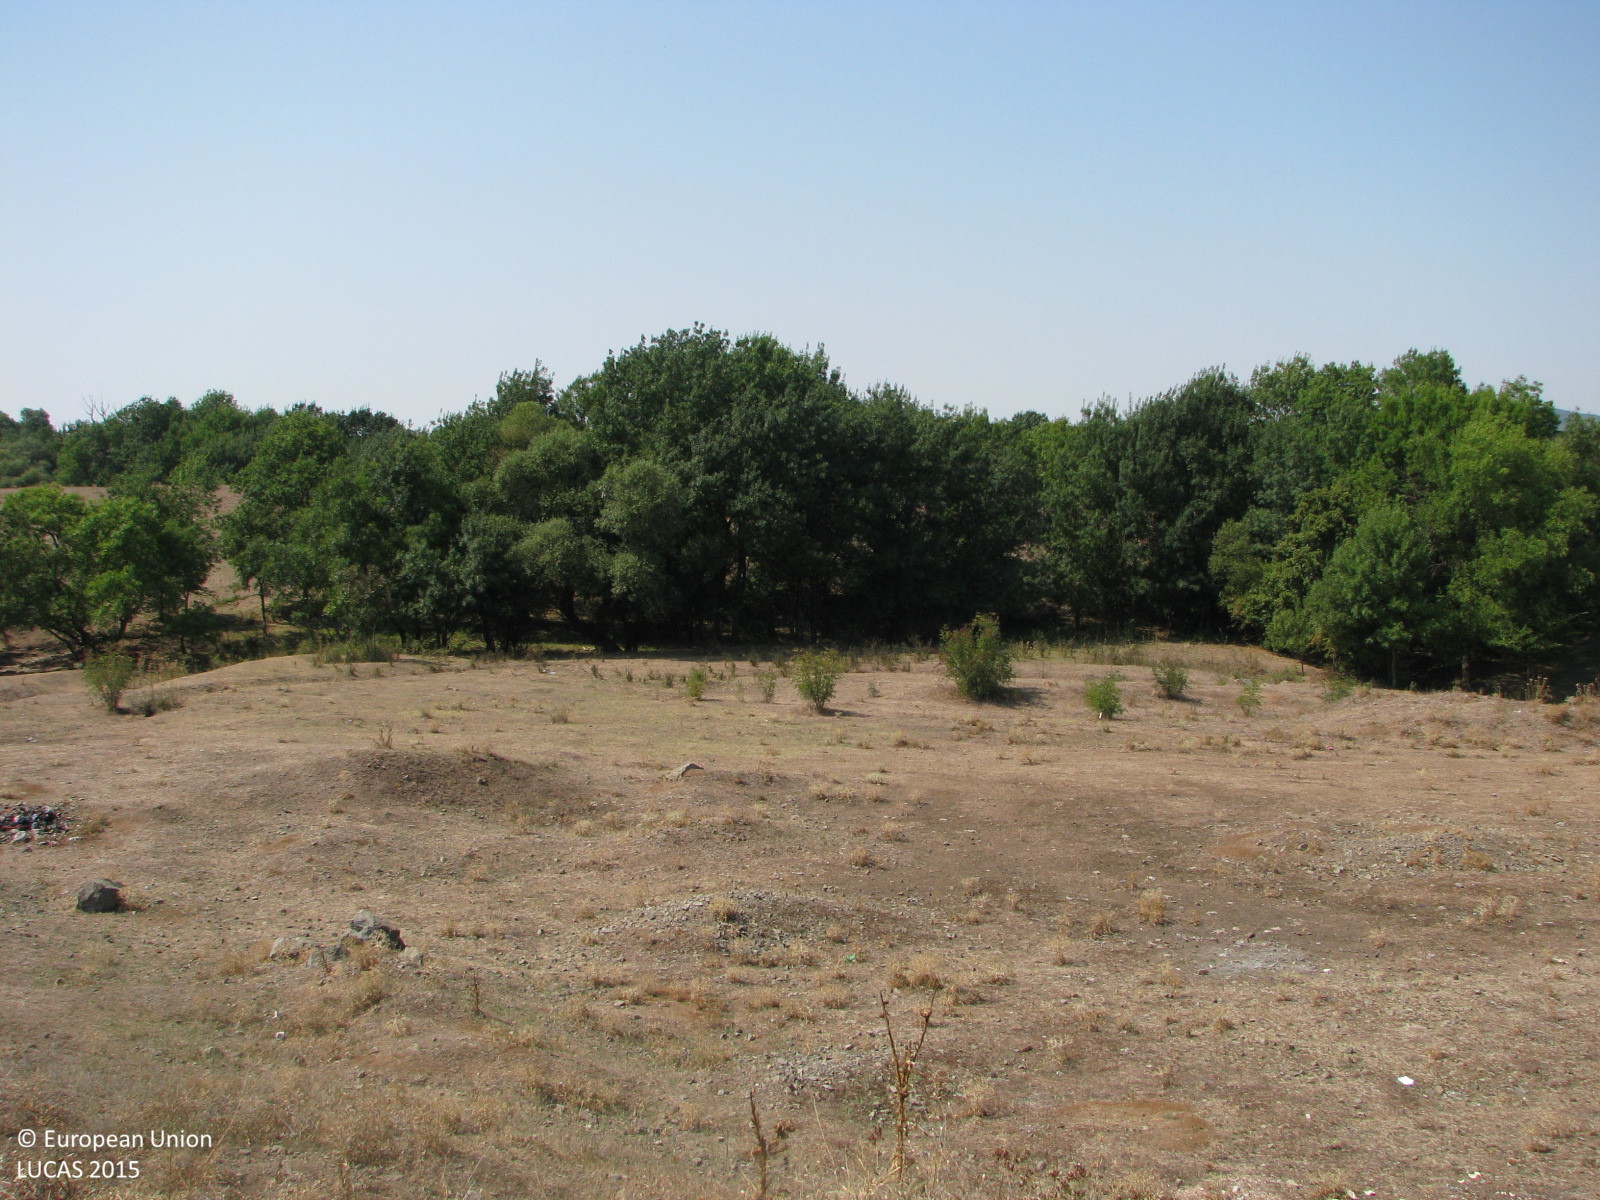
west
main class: Grassland
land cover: Grassland without tree/shrub cover
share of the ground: > 75 %
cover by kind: herbaceous plants 90 %, unconsolidated bare surface 10 %
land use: Agriculture (excluding fallow land and kitchen gardens)
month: September
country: BG
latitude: 42.3805
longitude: 26.7979
